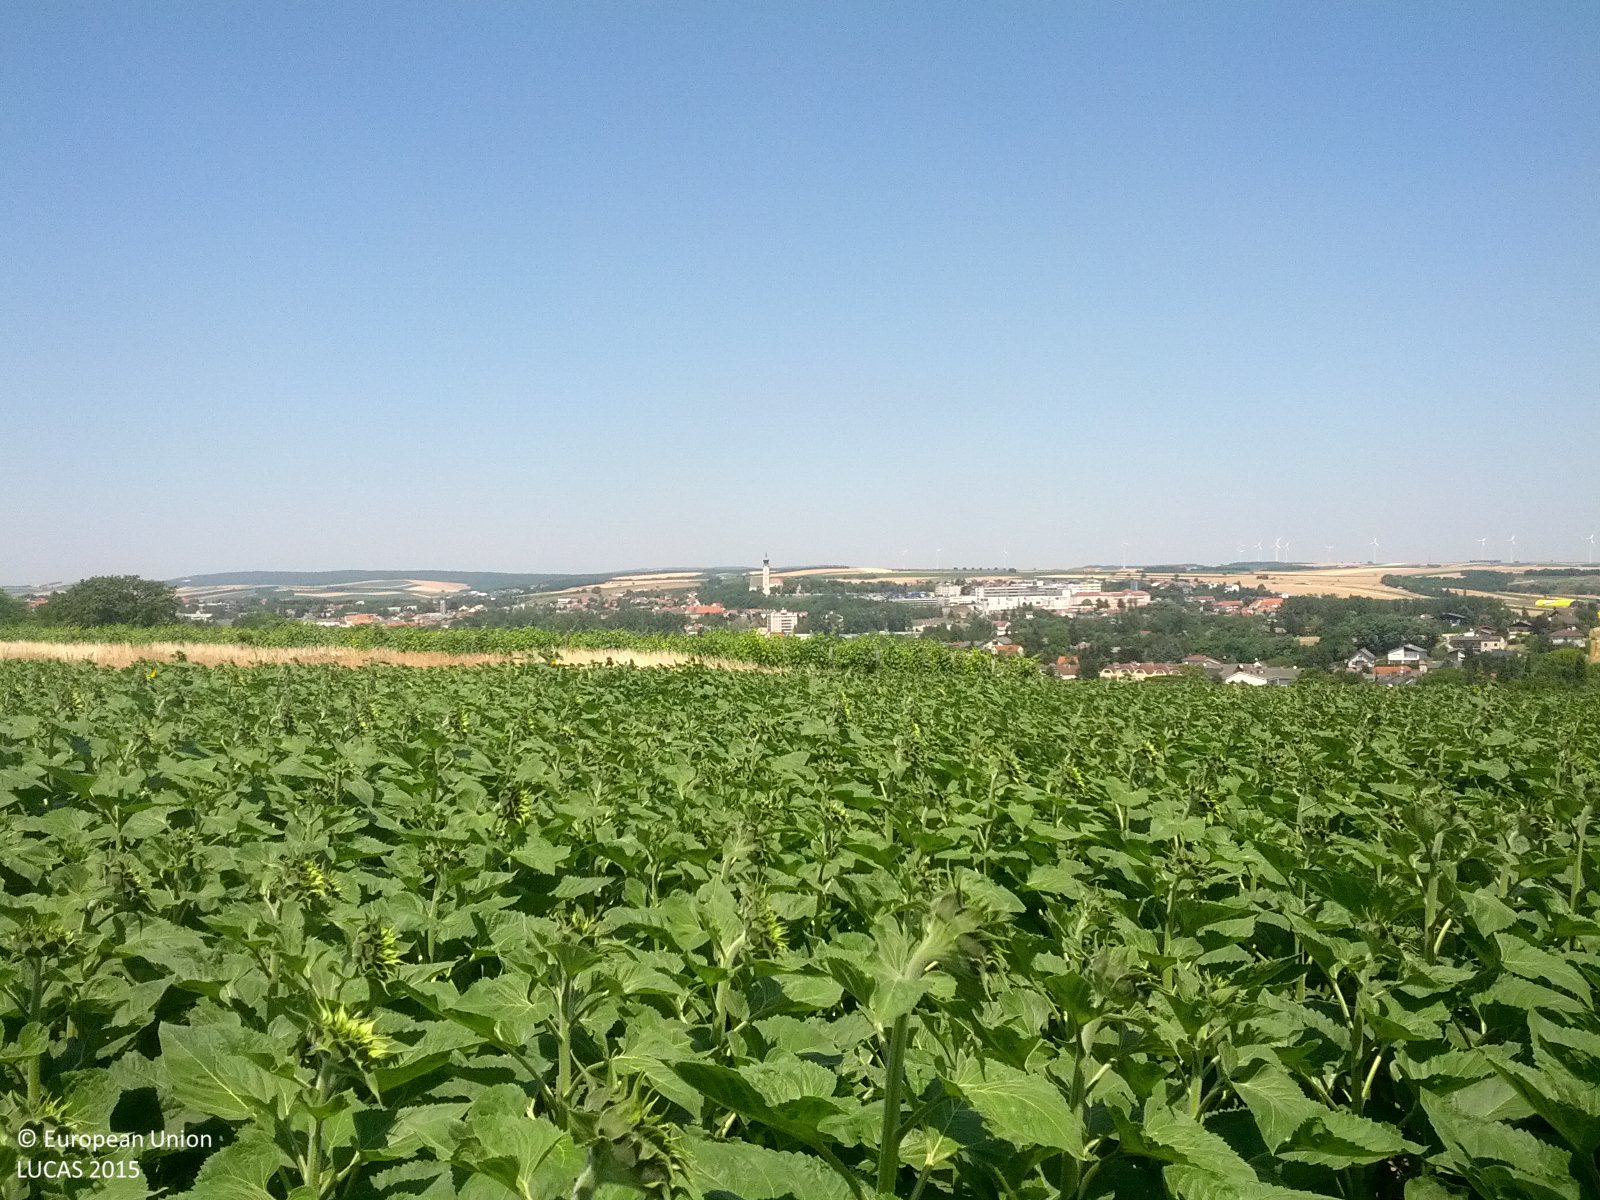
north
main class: Cropland
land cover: Sunflower
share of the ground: > 75 %
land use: Agriculture (excluding fallow land and kitchen gardens)
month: July
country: AT
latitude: 48.5506
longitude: 16.5768
